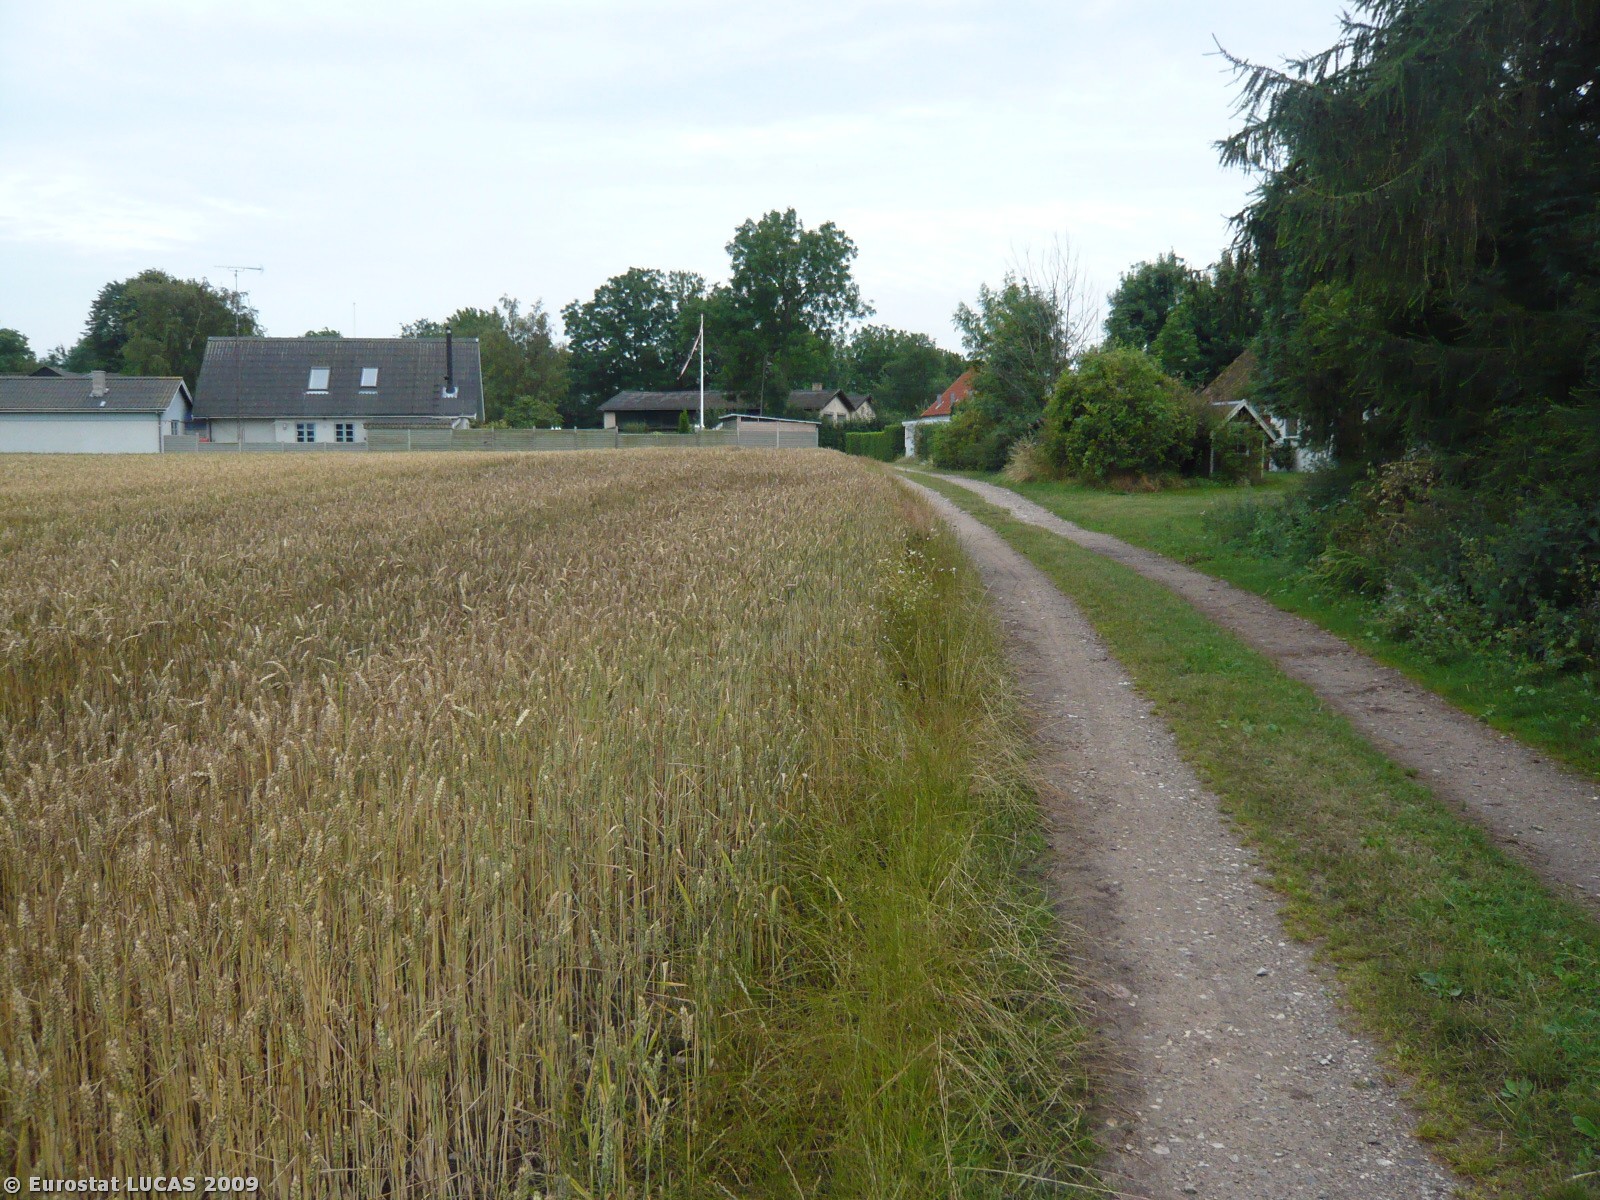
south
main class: Cropland
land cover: Common wheat
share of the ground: > 75 %
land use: Agriculture (excluding fallow land and kitchen gardens)
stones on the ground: 25 - 50 %
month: July
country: DK
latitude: 55.8122
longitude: 12.0247
